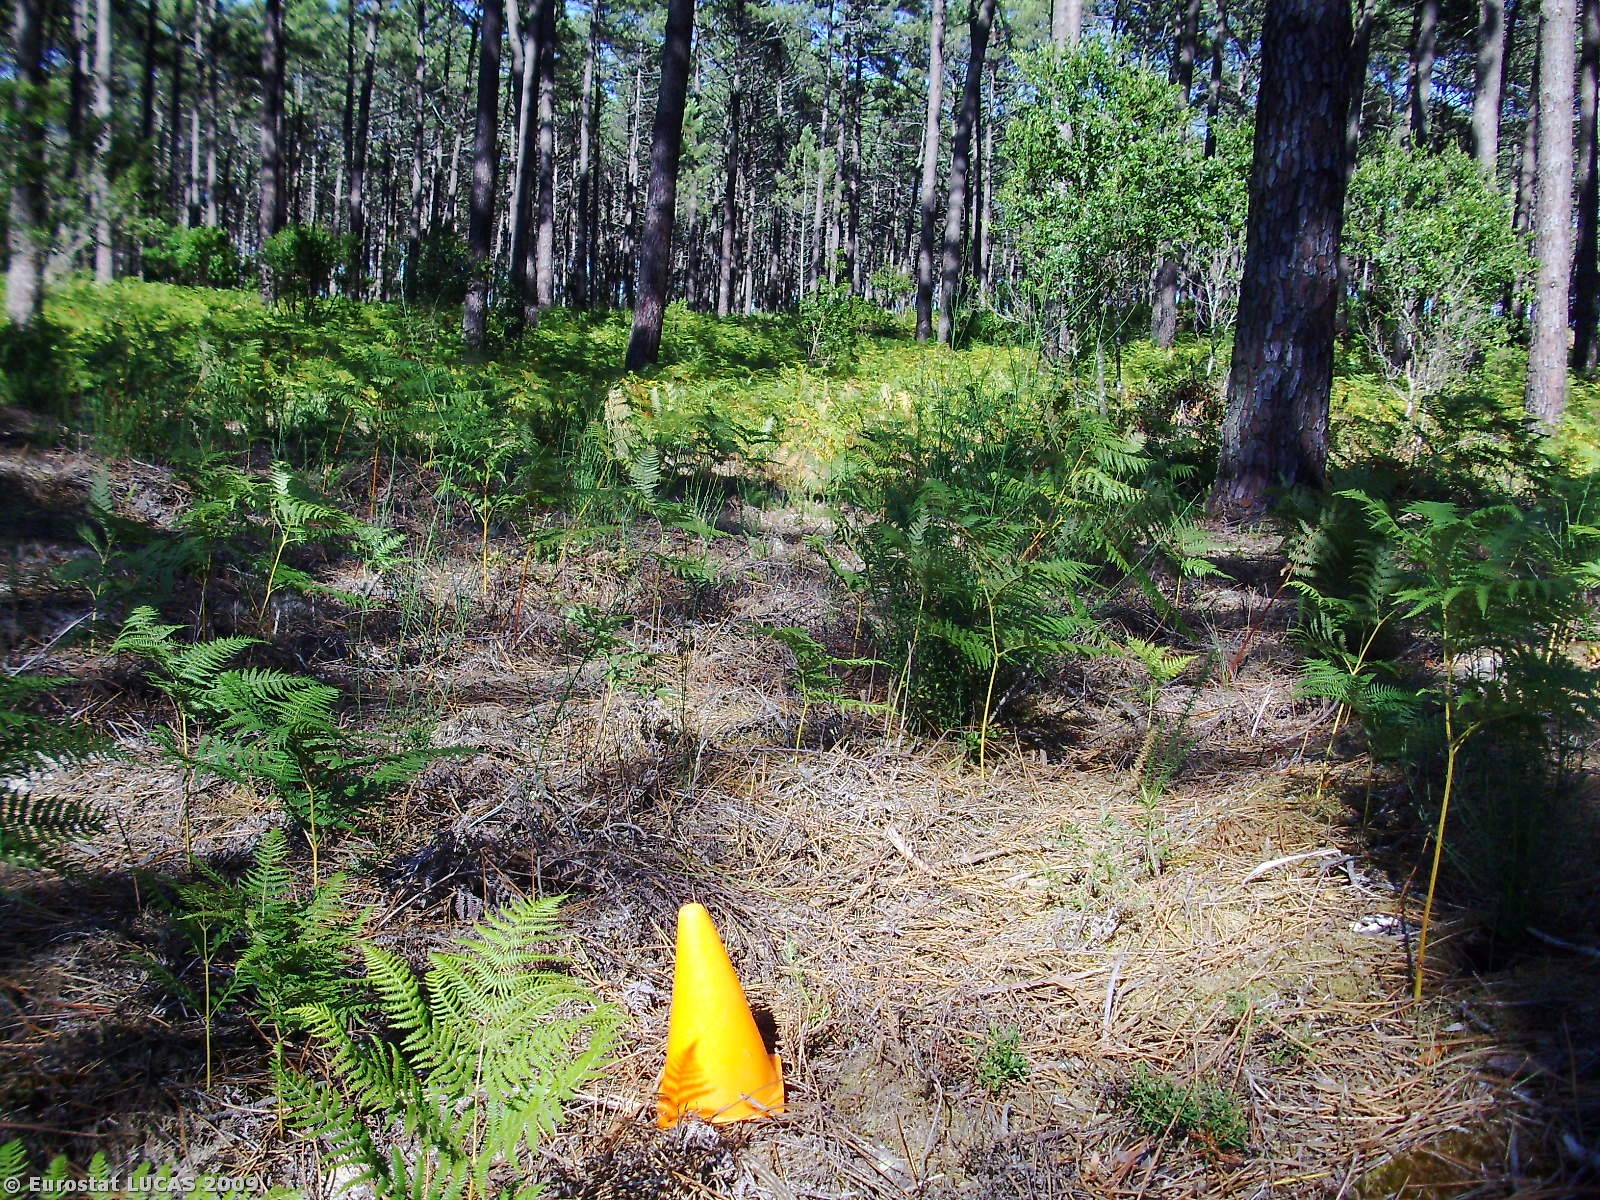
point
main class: Woodland
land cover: Coniferous woodland
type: coniferous forest of the mediterranean region
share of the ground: > 75 %
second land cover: Shrubland with sparse tree cover
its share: 10 - 25 %
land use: Forestry
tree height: > 5 m
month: July
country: PT
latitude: 39.7639
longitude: -8.9905
